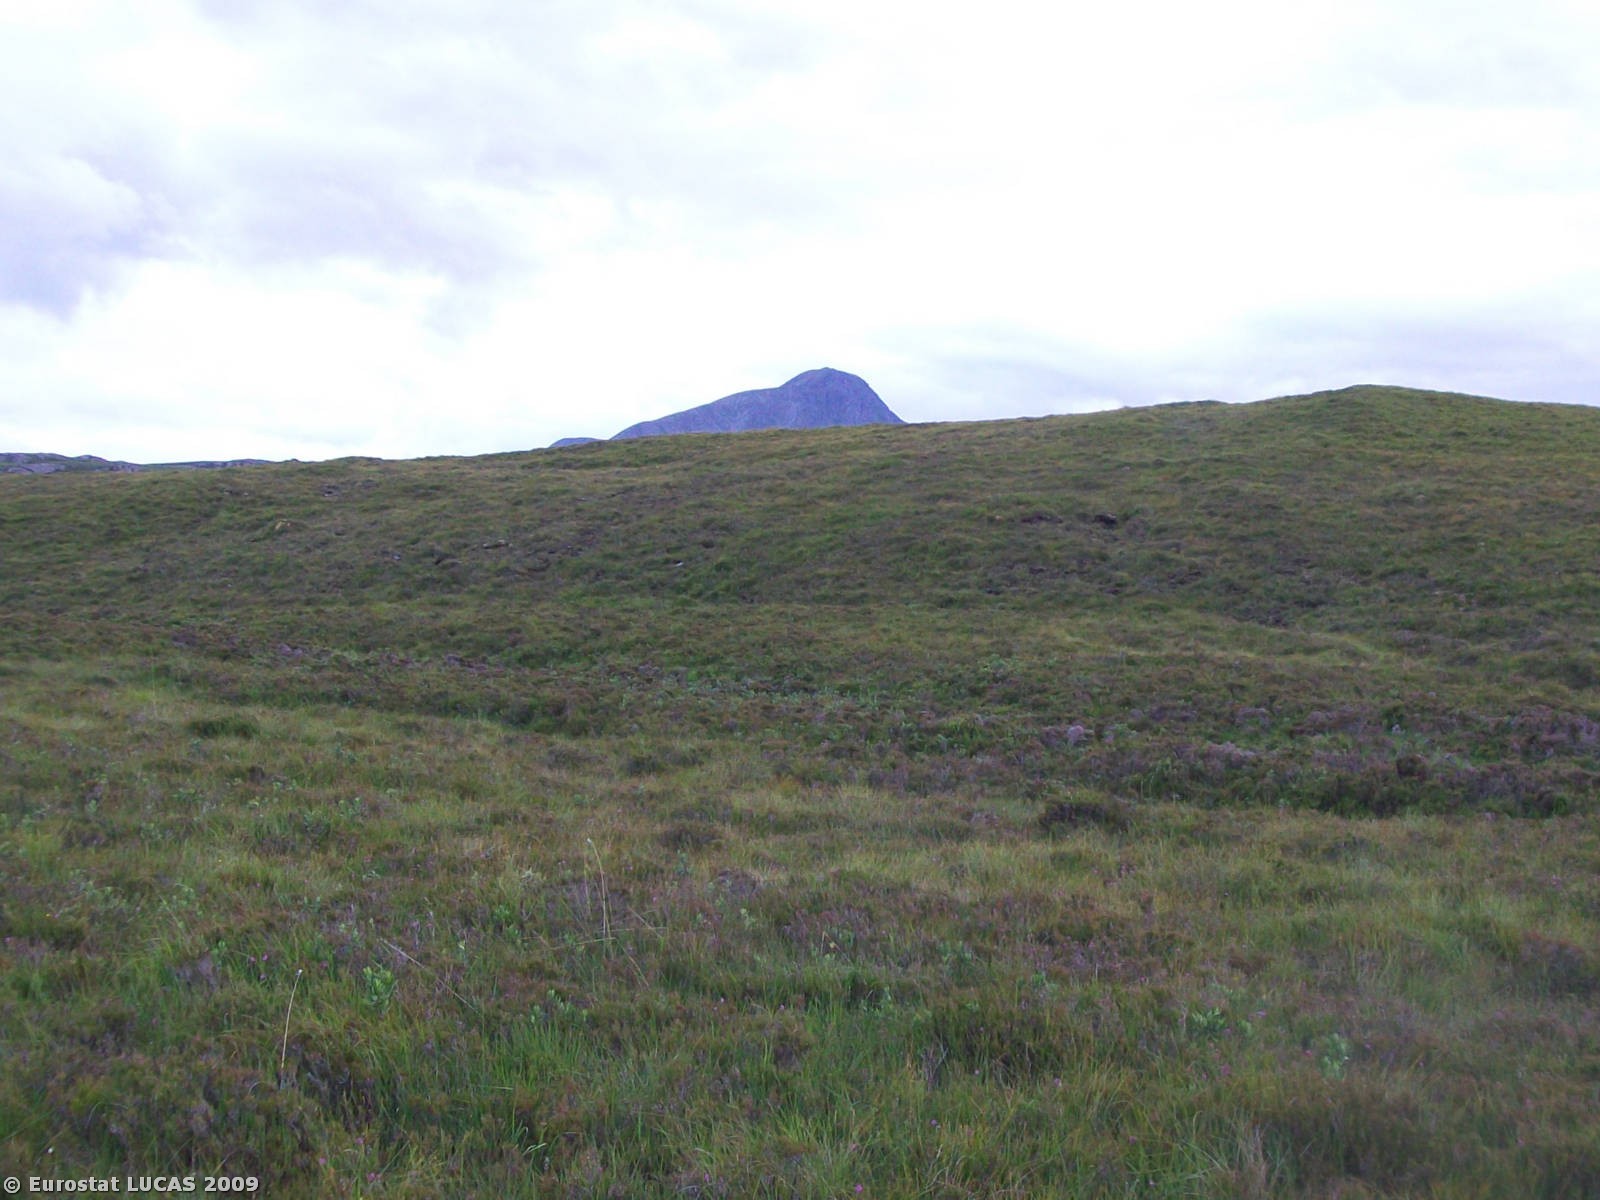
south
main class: Shrubland
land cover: Shrubland without tree cover
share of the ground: > 75 %
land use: Agriculture (excluding fallow land and kitchen gardens)
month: July
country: GB
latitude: 58.4779
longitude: -4.6124
